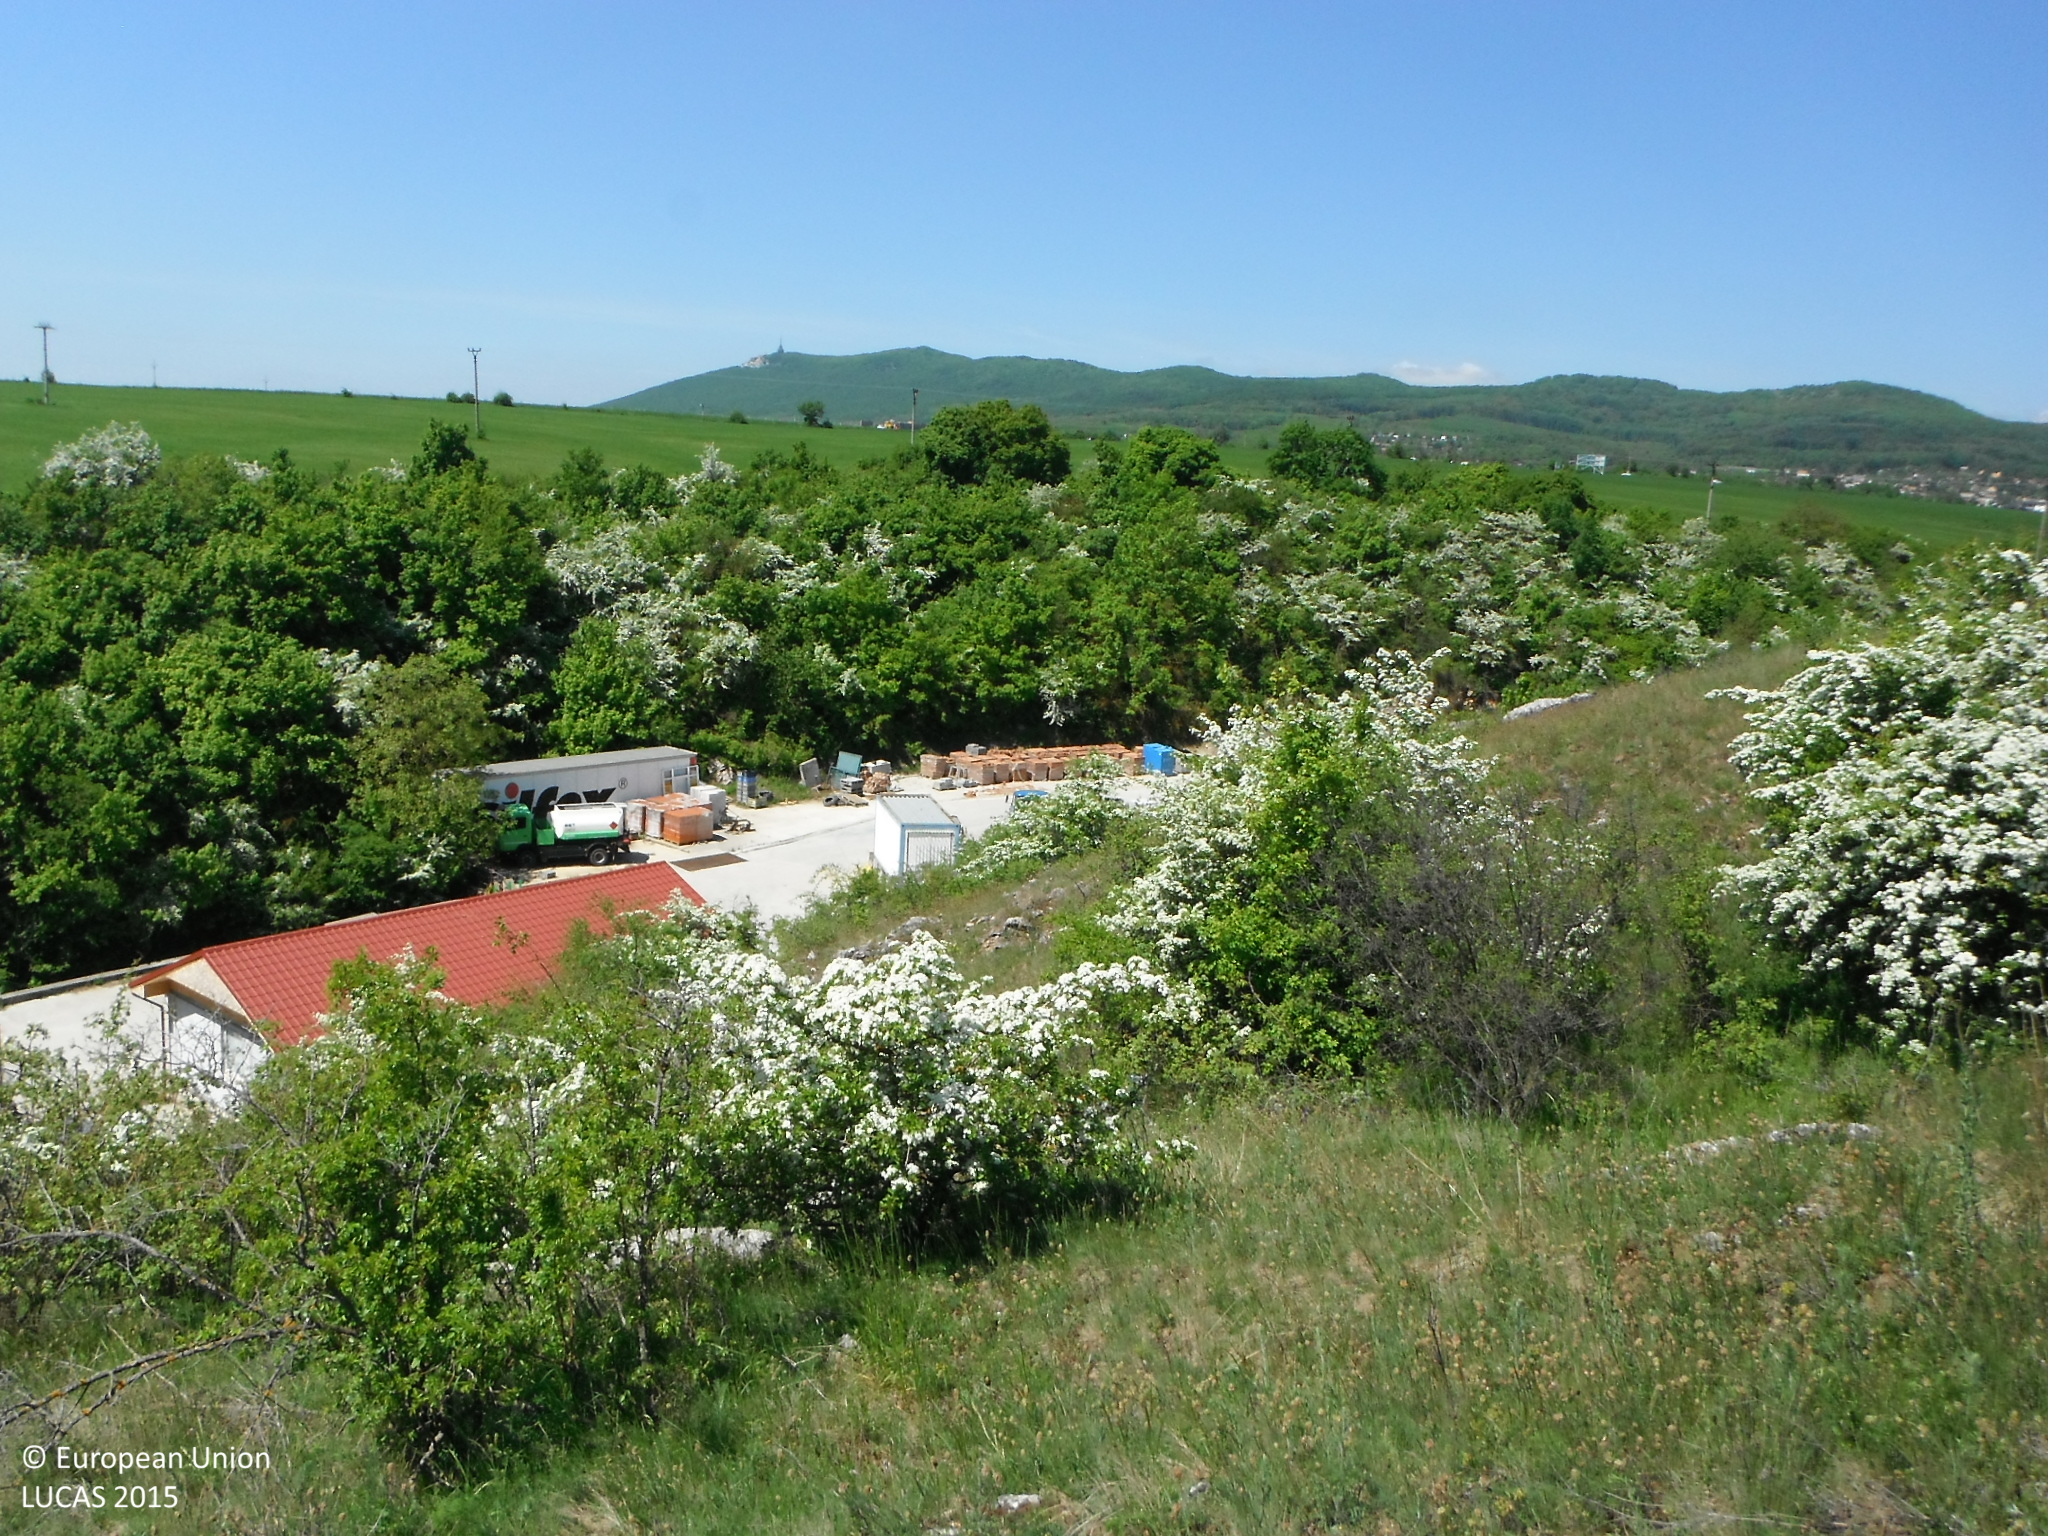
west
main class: Grassland
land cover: Spontaneously vegetated surfaces
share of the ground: > 75 %
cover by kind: herbaceous plants 95 %, shrubs 5 %
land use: Semi-natural and natural areas not in use
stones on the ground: 10 - 25 %
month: May
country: SK
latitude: 48.3355
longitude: 18.1758
